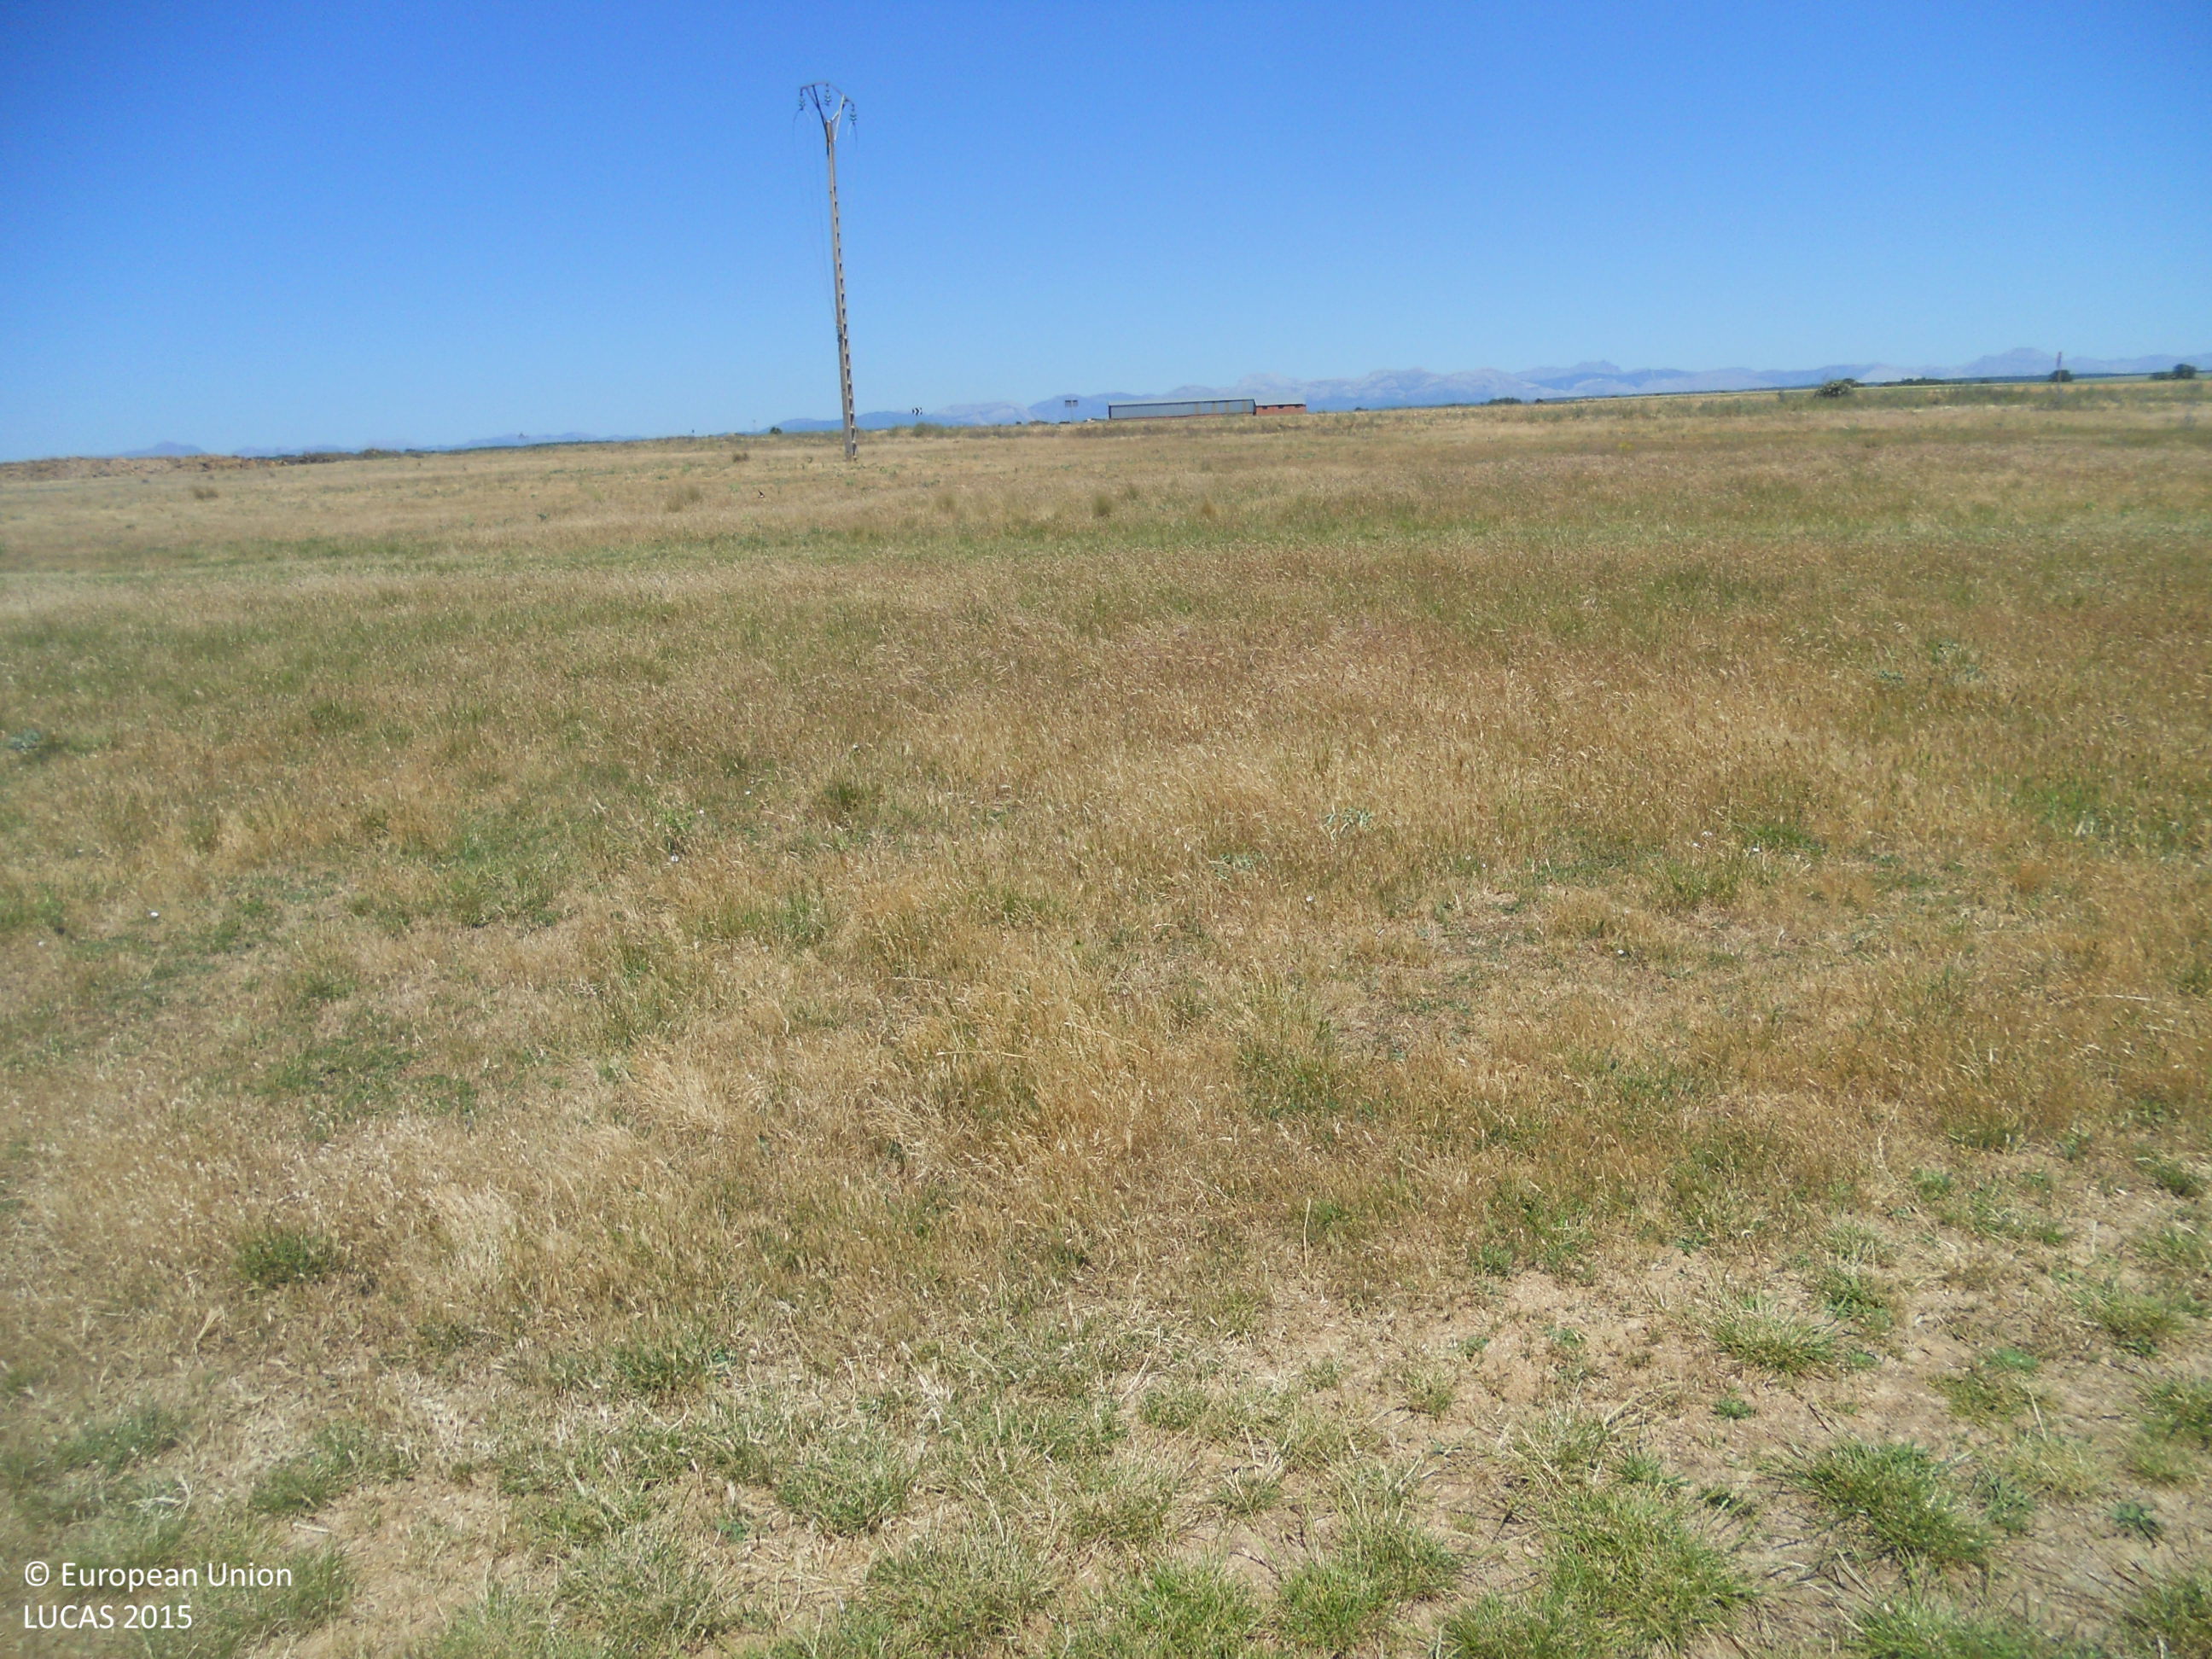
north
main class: Grassland
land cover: Grassland without tree/shrub cover
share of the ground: > 75 %
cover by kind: herbaceous plants 100 %
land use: Abandoned areas
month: June
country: ES
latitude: 42.5277
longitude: -4.8242
